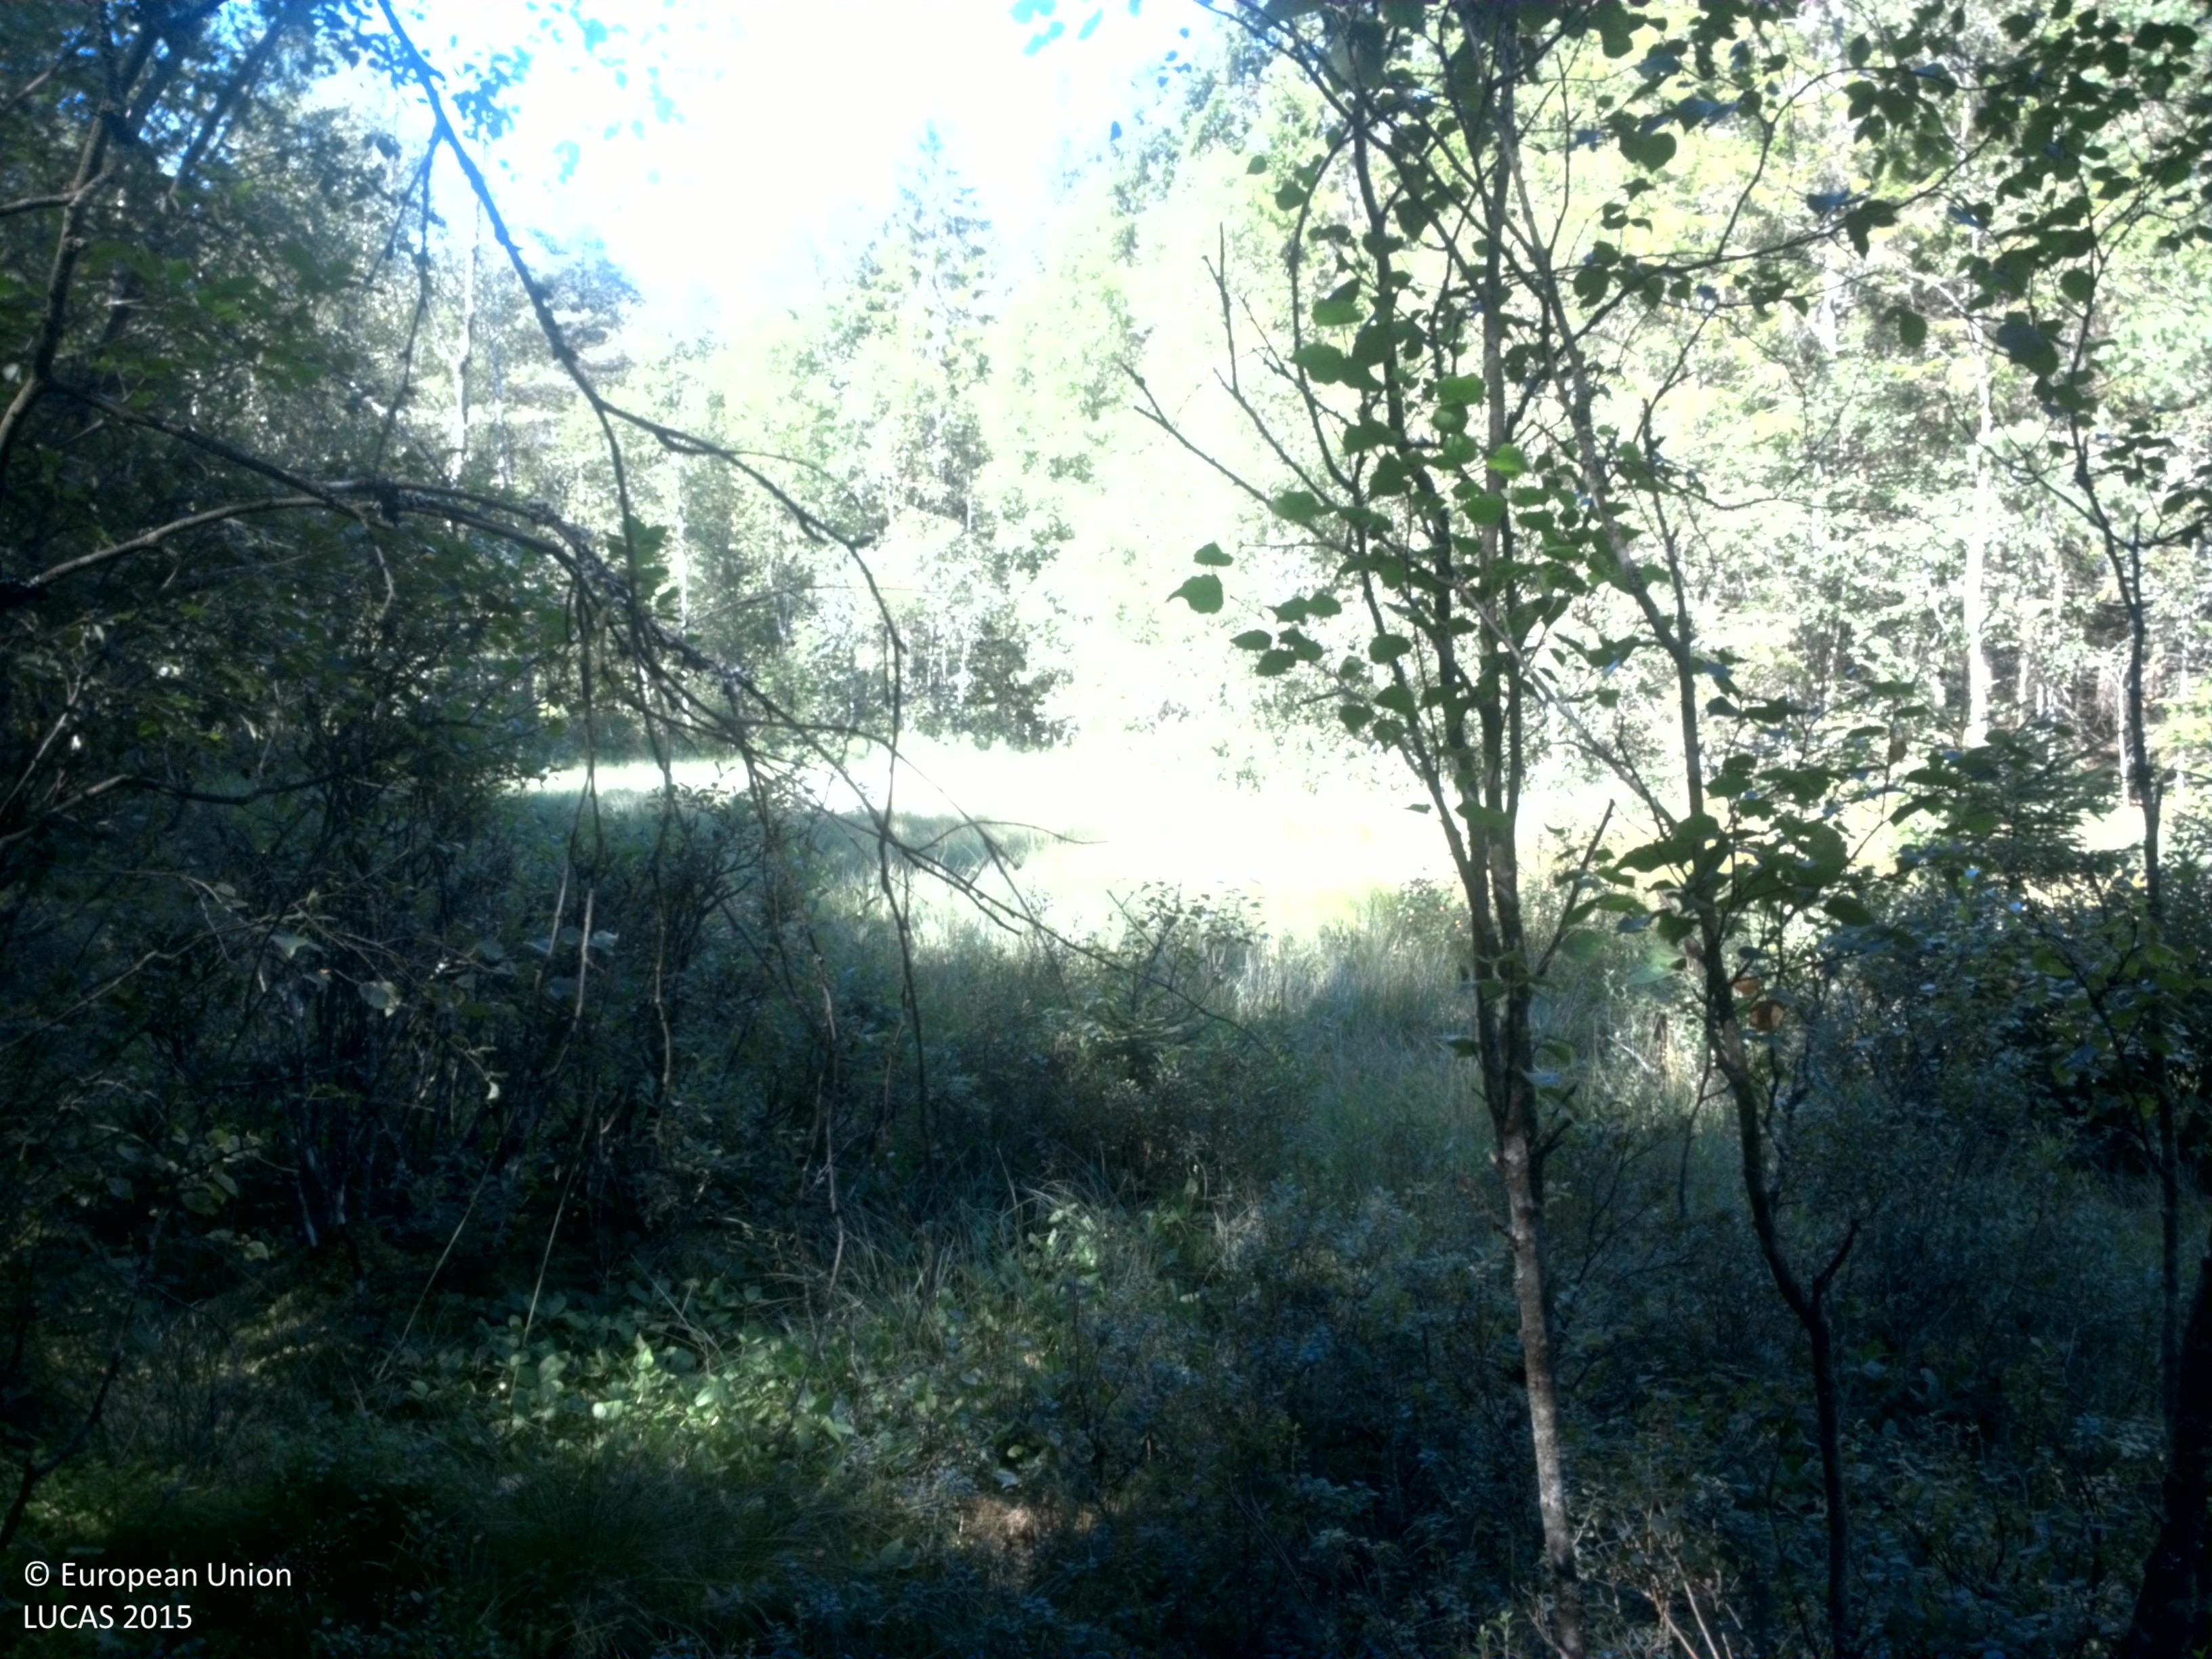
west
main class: Woodland
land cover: Spruce dominated mixed woodland
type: boreal forest
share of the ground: 50 - 75 %
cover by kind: coniferous forest trees 25 %, broadleaved forest trees 25 %, herbaceous plants 25 %, lichens and mosses 25 %
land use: Forestry
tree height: > 5 m
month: August
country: SE
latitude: 58.1249
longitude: 13.3055
